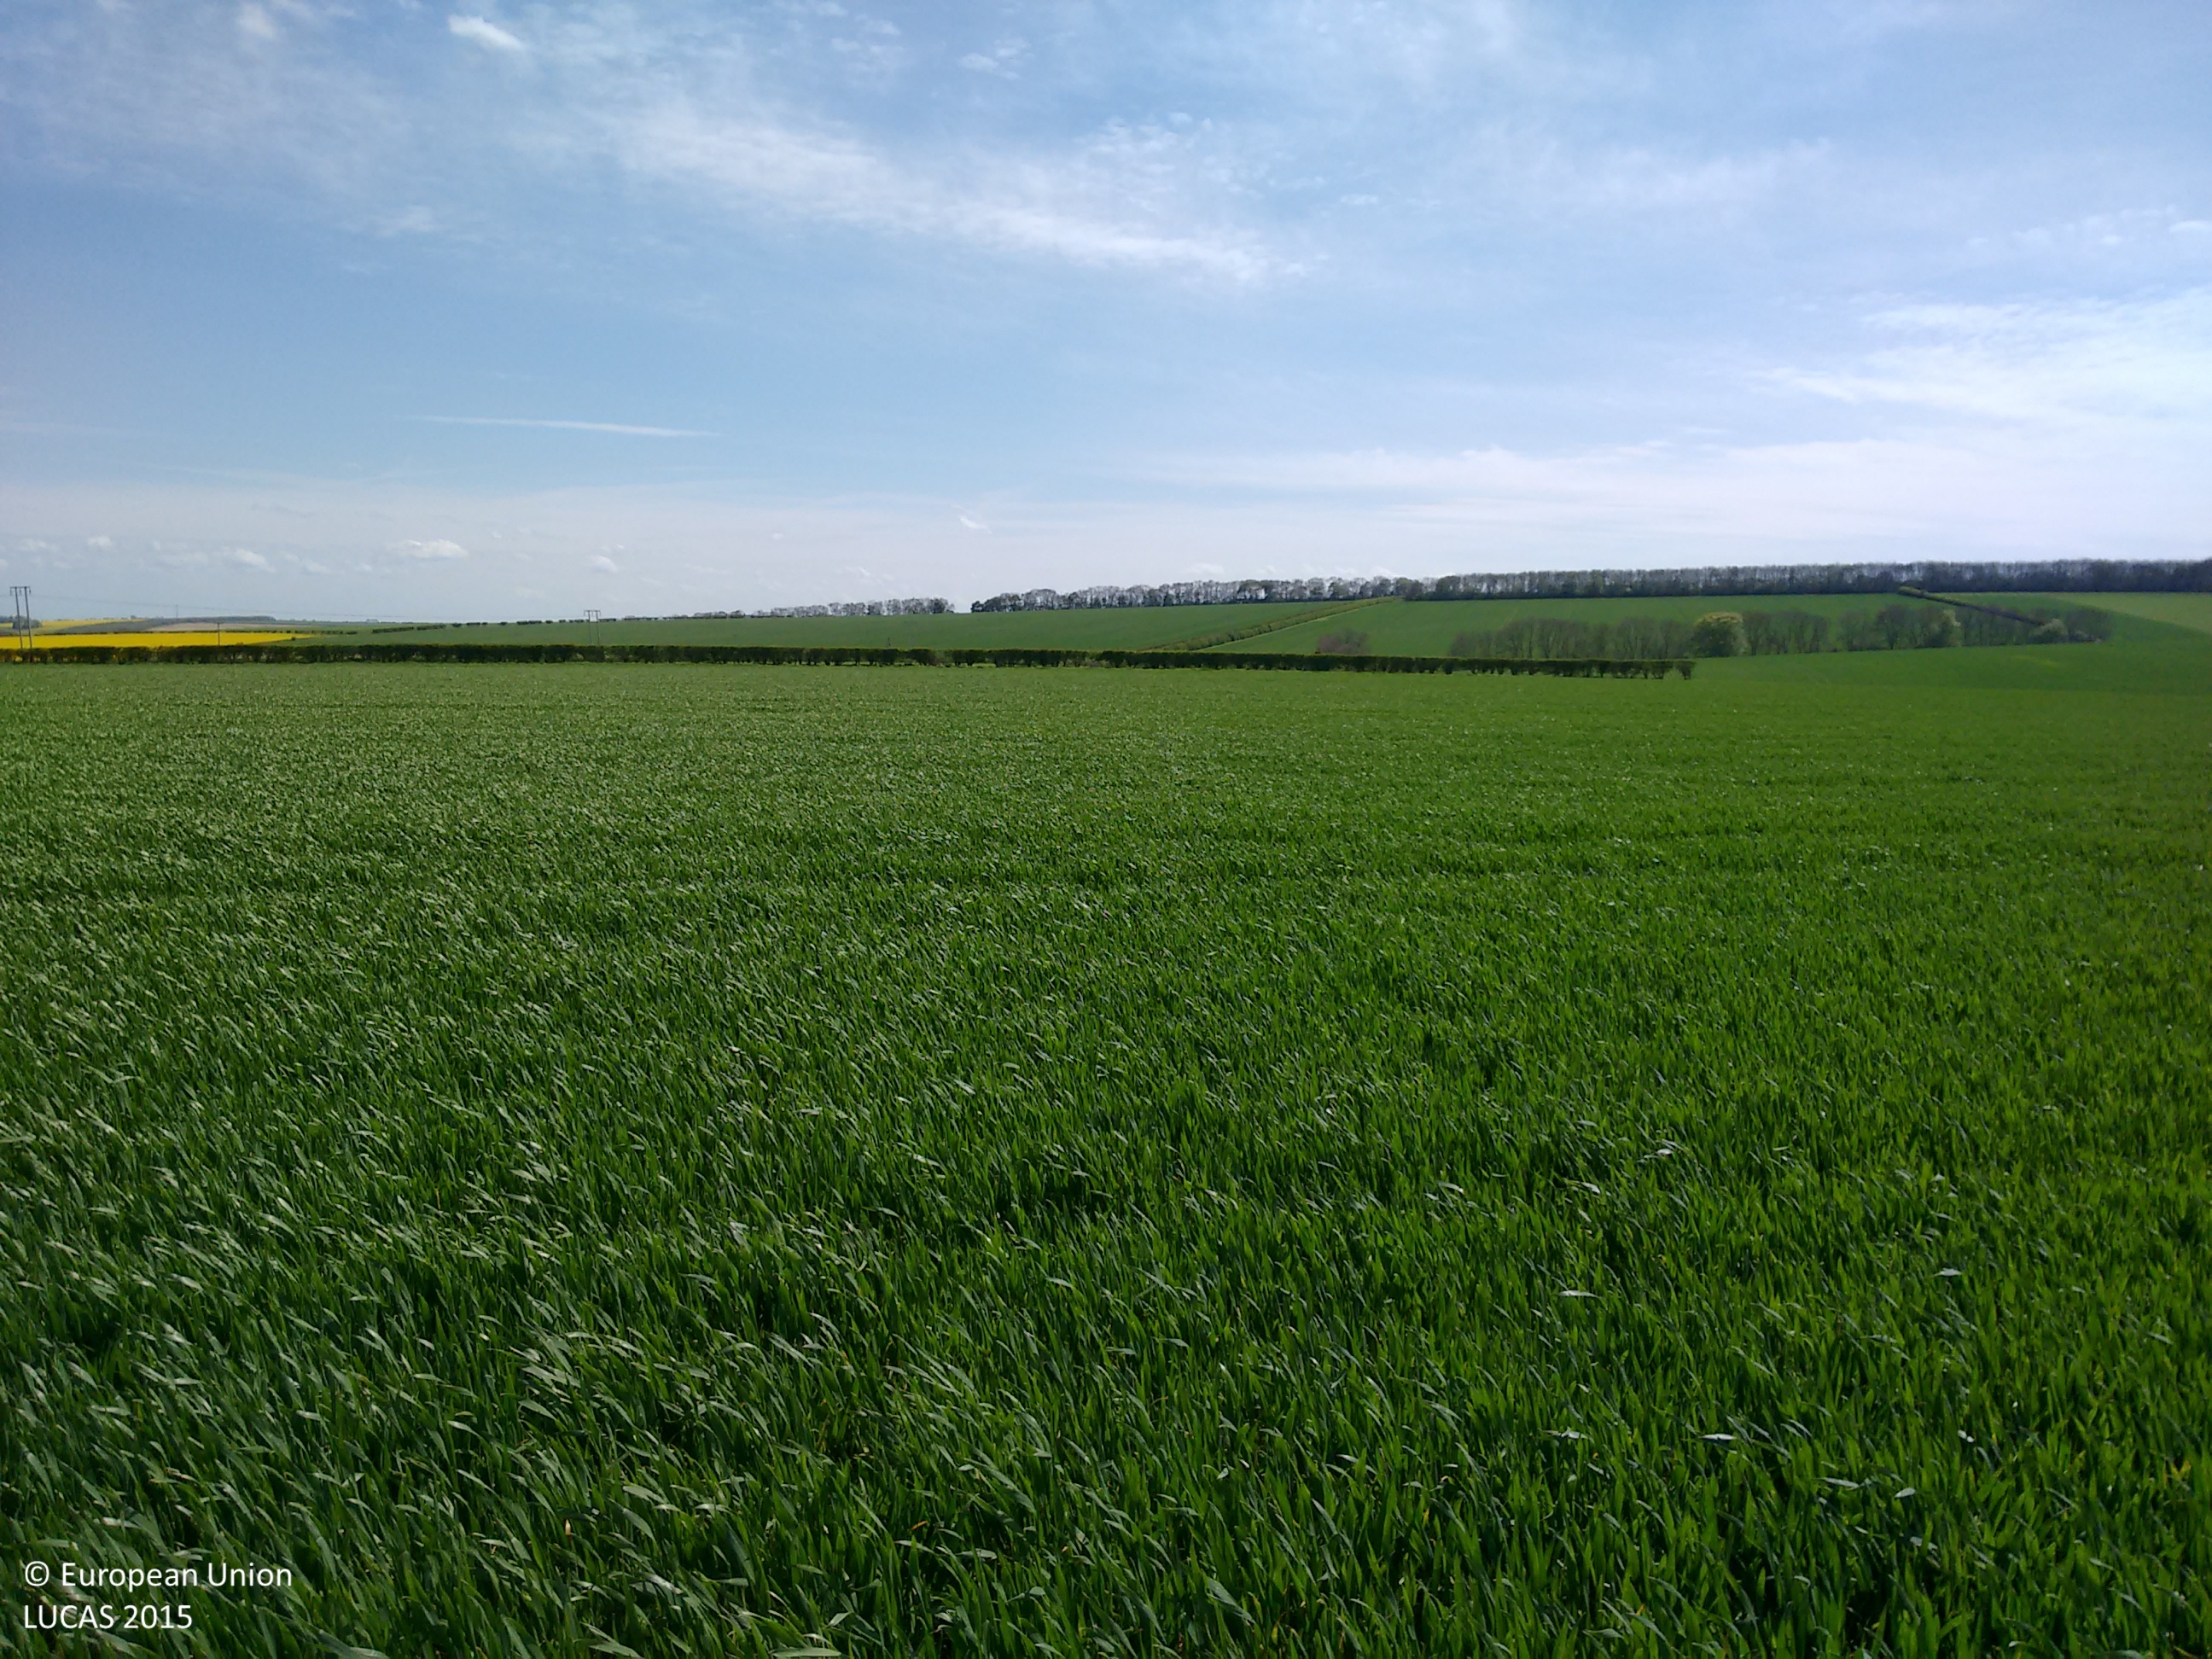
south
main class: Cropland
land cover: Common wheat
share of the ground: > 75 %
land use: Agriculture (excluding fallow land and kitchen gardens)
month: May
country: GB
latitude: 54.1167
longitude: -0.3613
